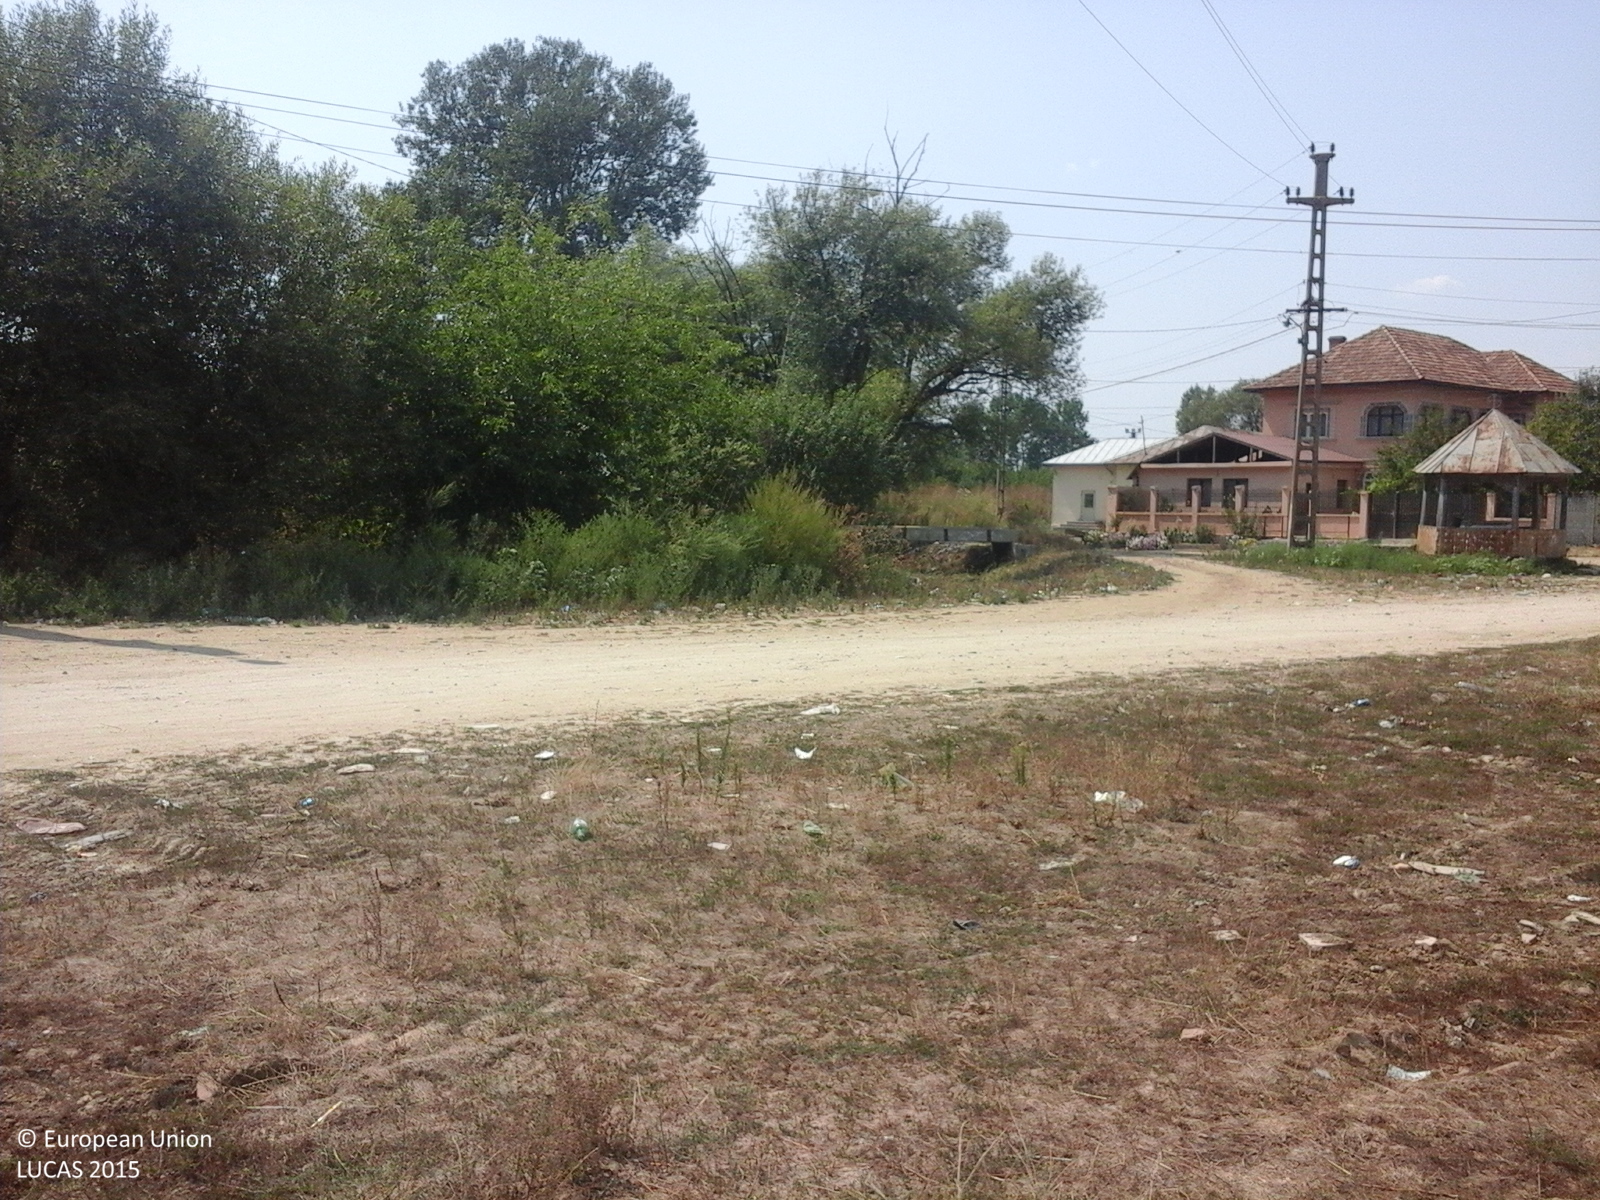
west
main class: Grassland
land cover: Spontaneously vegetated surfaces
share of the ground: > 75 %
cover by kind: herbaceous plants 100 %
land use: Residential
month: August
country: RO
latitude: 44.5869
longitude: 23.5704
